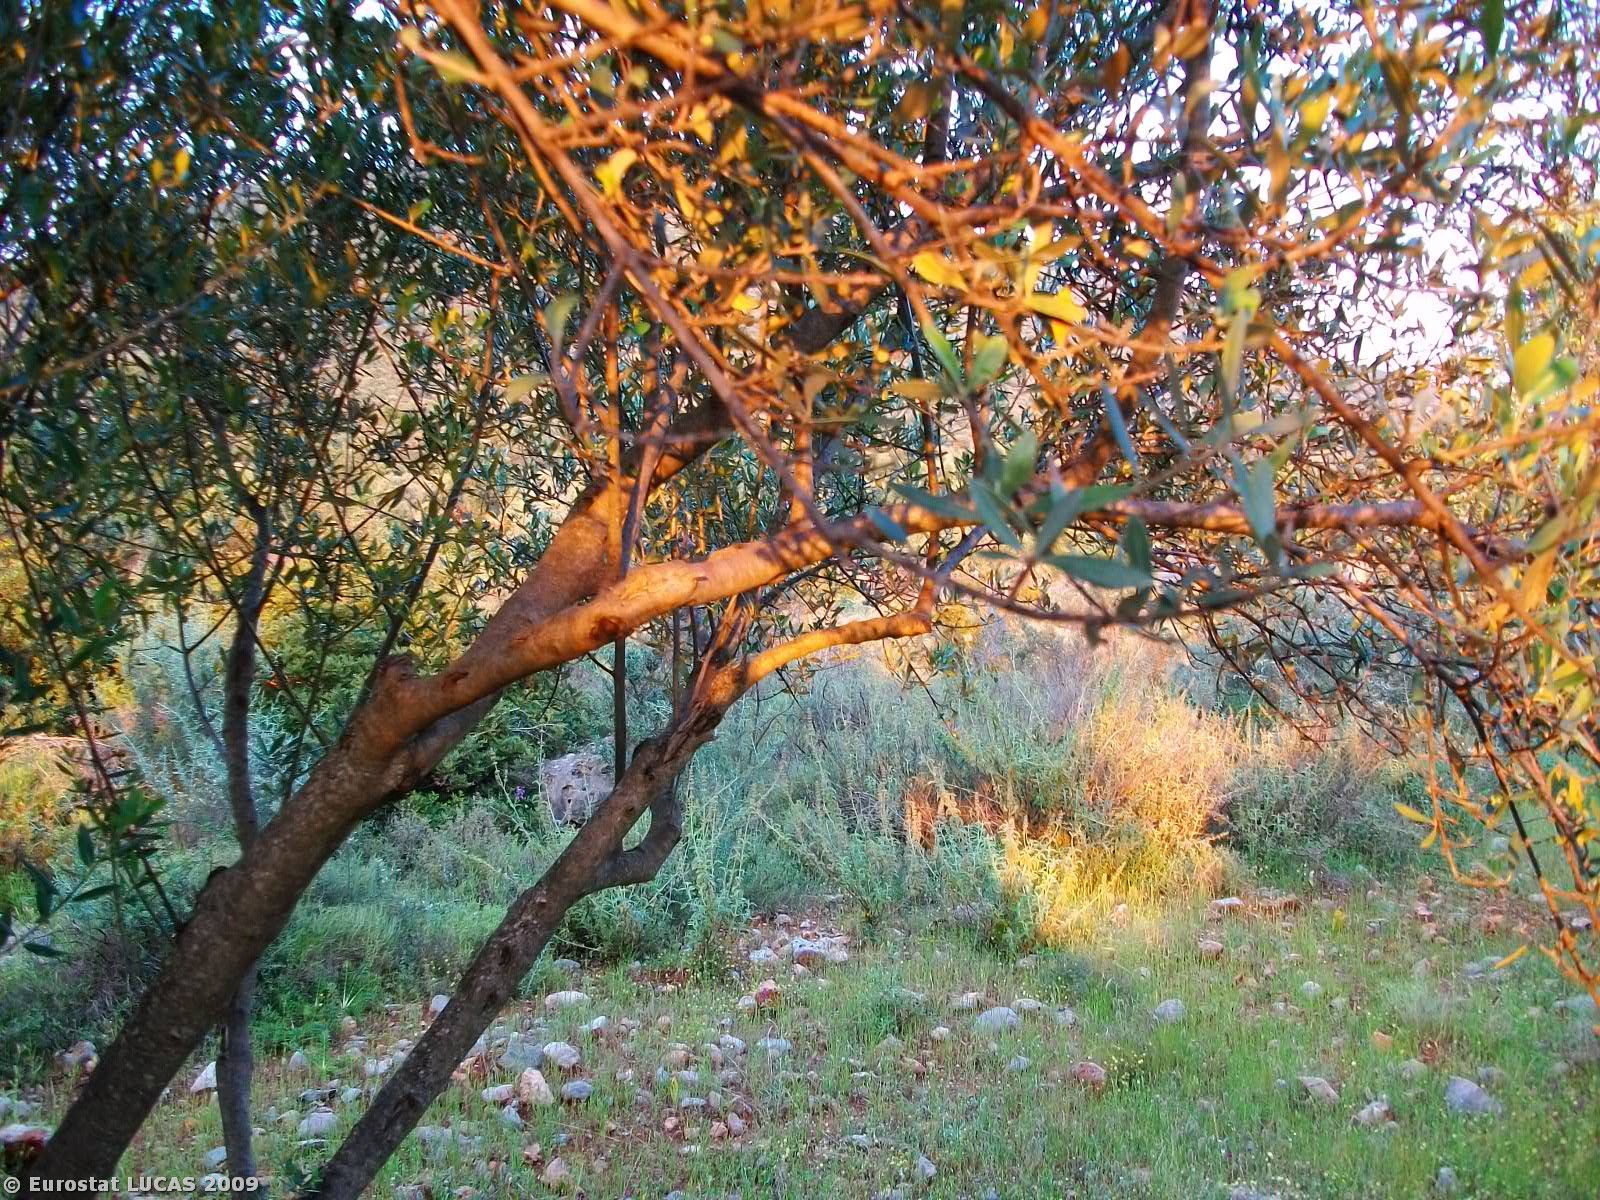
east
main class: Cropland
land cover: Olive groves
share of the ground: 50 - 75 %
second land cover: Grassland with sparse tree/shrub cover
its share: 50 - 75 %
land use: Agriculture (excluding fallow land and kitchen gardens)
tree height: < 5 m
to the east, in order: Olive groves; Grassland with sparse tree/shrub cover; Shrubland with sparse tree cover; Rivers and streams; Artificial constructions; Dry stone walls; Olive groves; Dry stone walls; Olive groves; Dry stone walls; Olive groves; Fences; Dry stone walls; Tracks; Olive groves
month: May
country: GR
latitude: 37.1838
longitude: 22.0190
